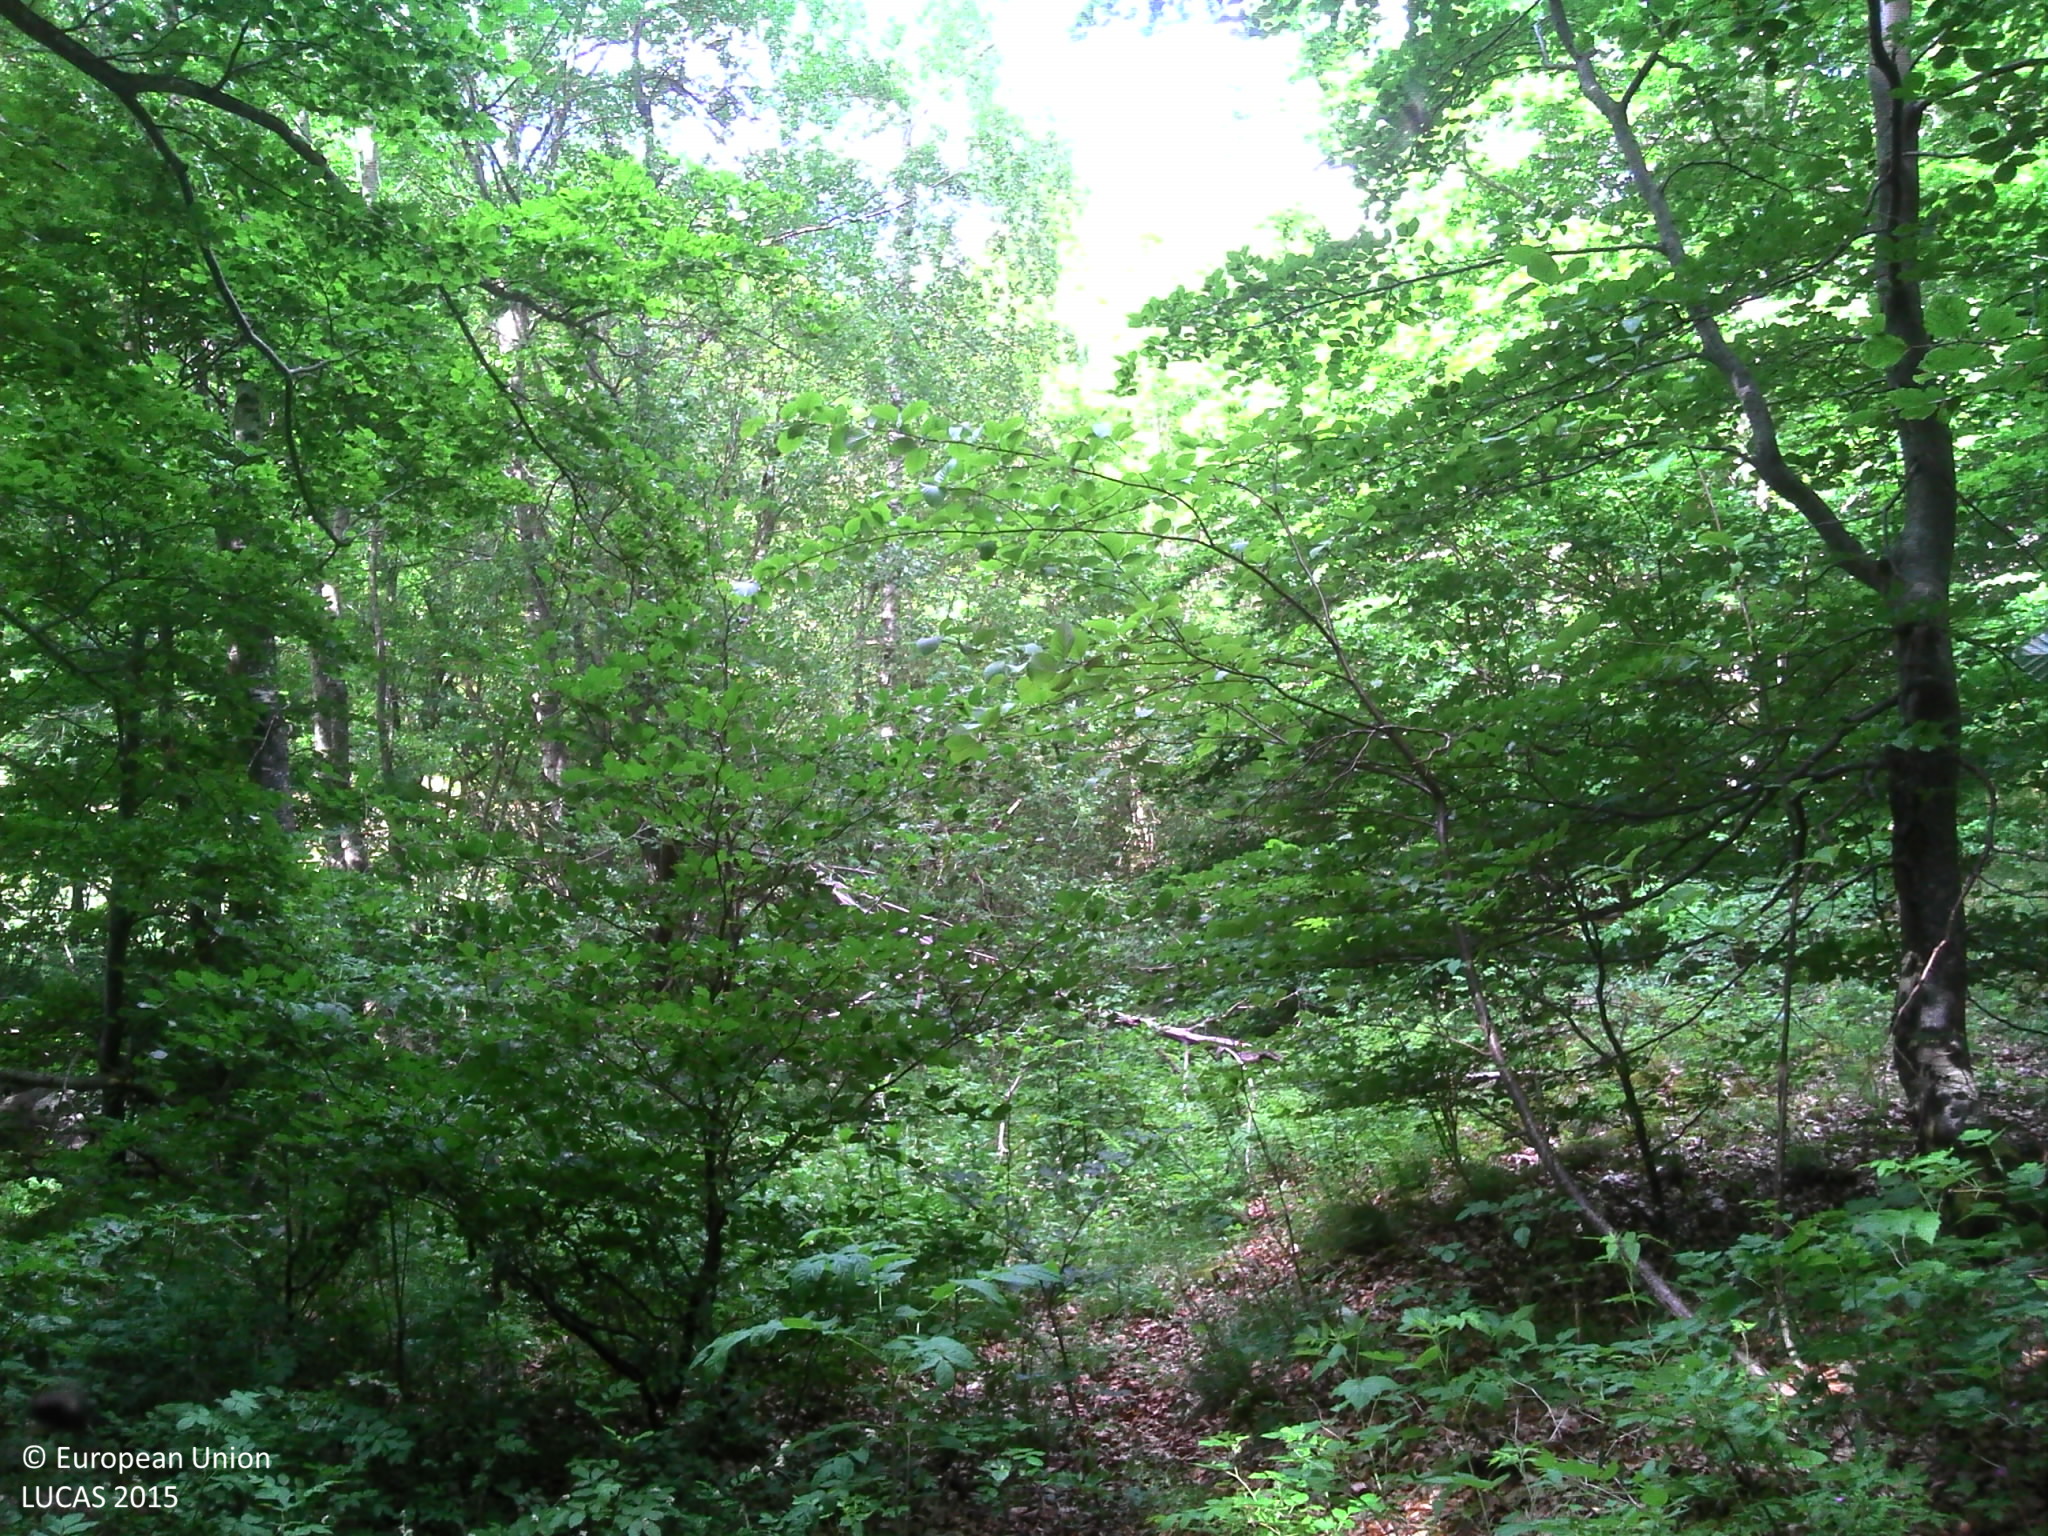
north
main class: Woodland
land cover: Broadleaved woodland
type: beech forest
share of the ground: > 75 %
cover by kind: broadleaved forest trees 95 %, coniferous forest trees 5 %
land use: Forestry
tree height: > 5 m
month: June
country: FR
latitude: 44.5673
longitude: 3.8737
